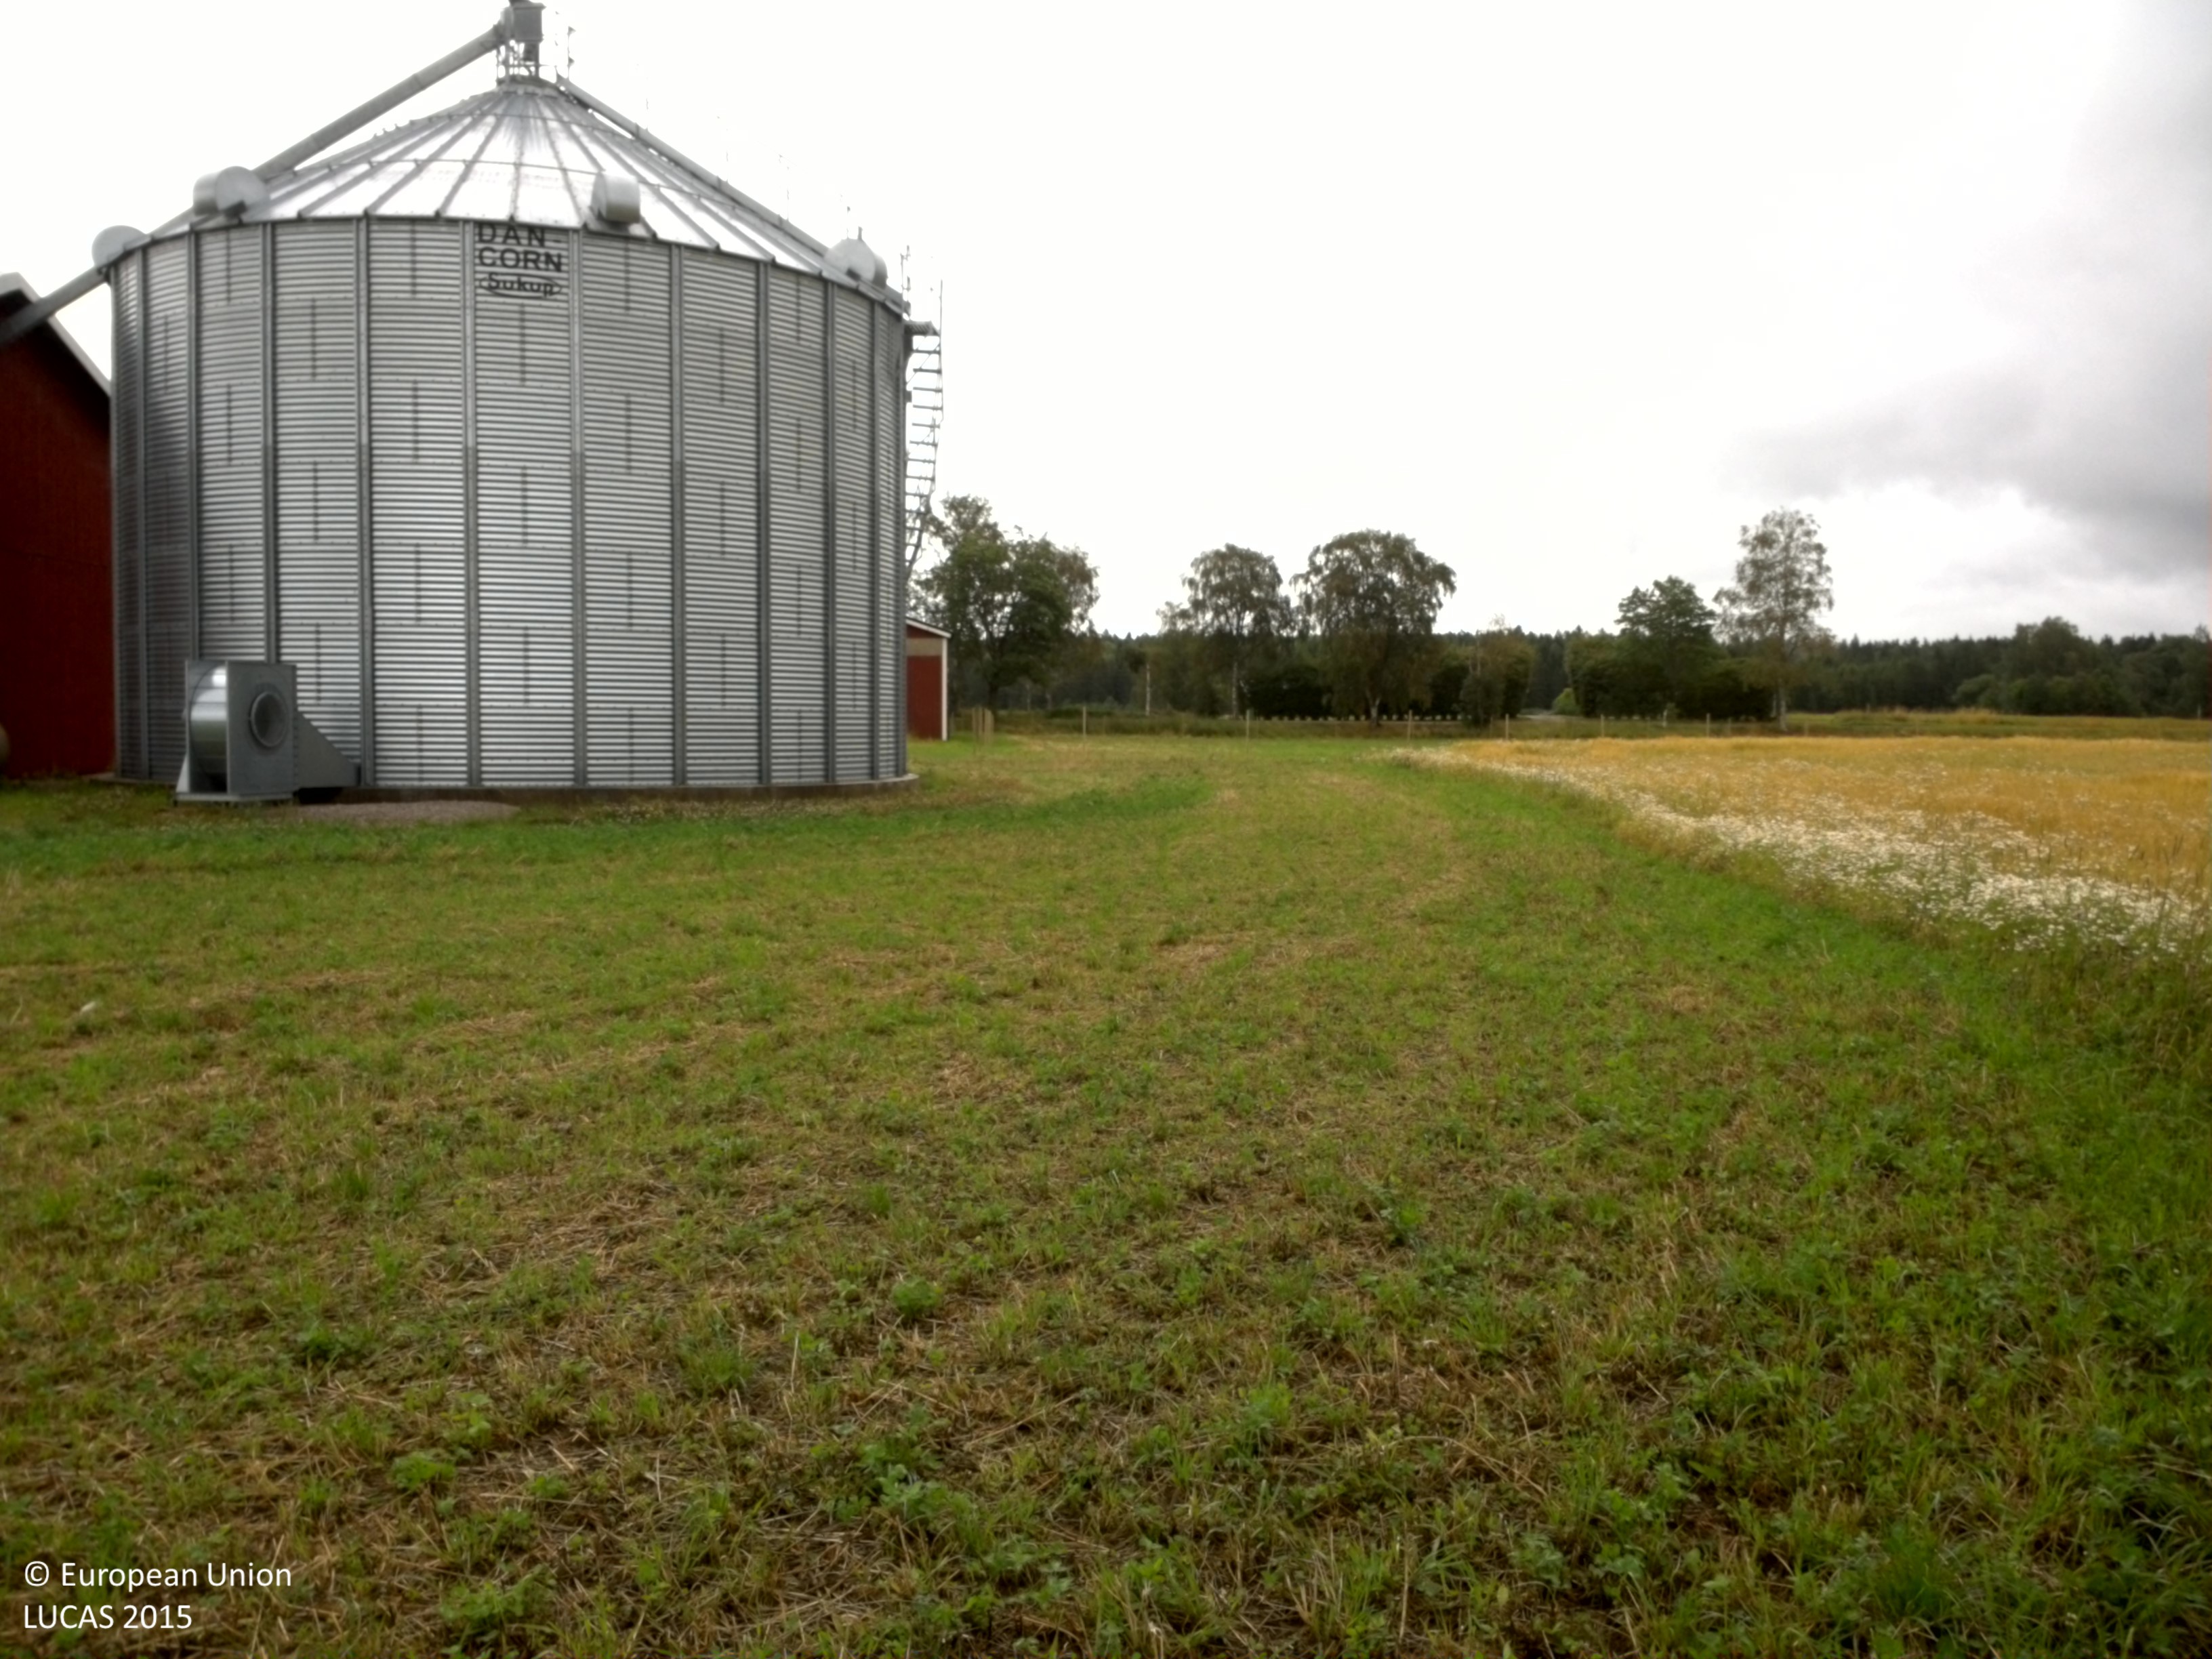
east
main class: Cropland
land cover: Barley
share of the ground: 25 - 50 %
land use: Agriculture (excluding fallow land and kitchen gardens)
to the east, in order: Barley; Other leguminous and mixtures for fodder
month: July
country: SE
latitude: 58.7379
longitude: 13.9493
